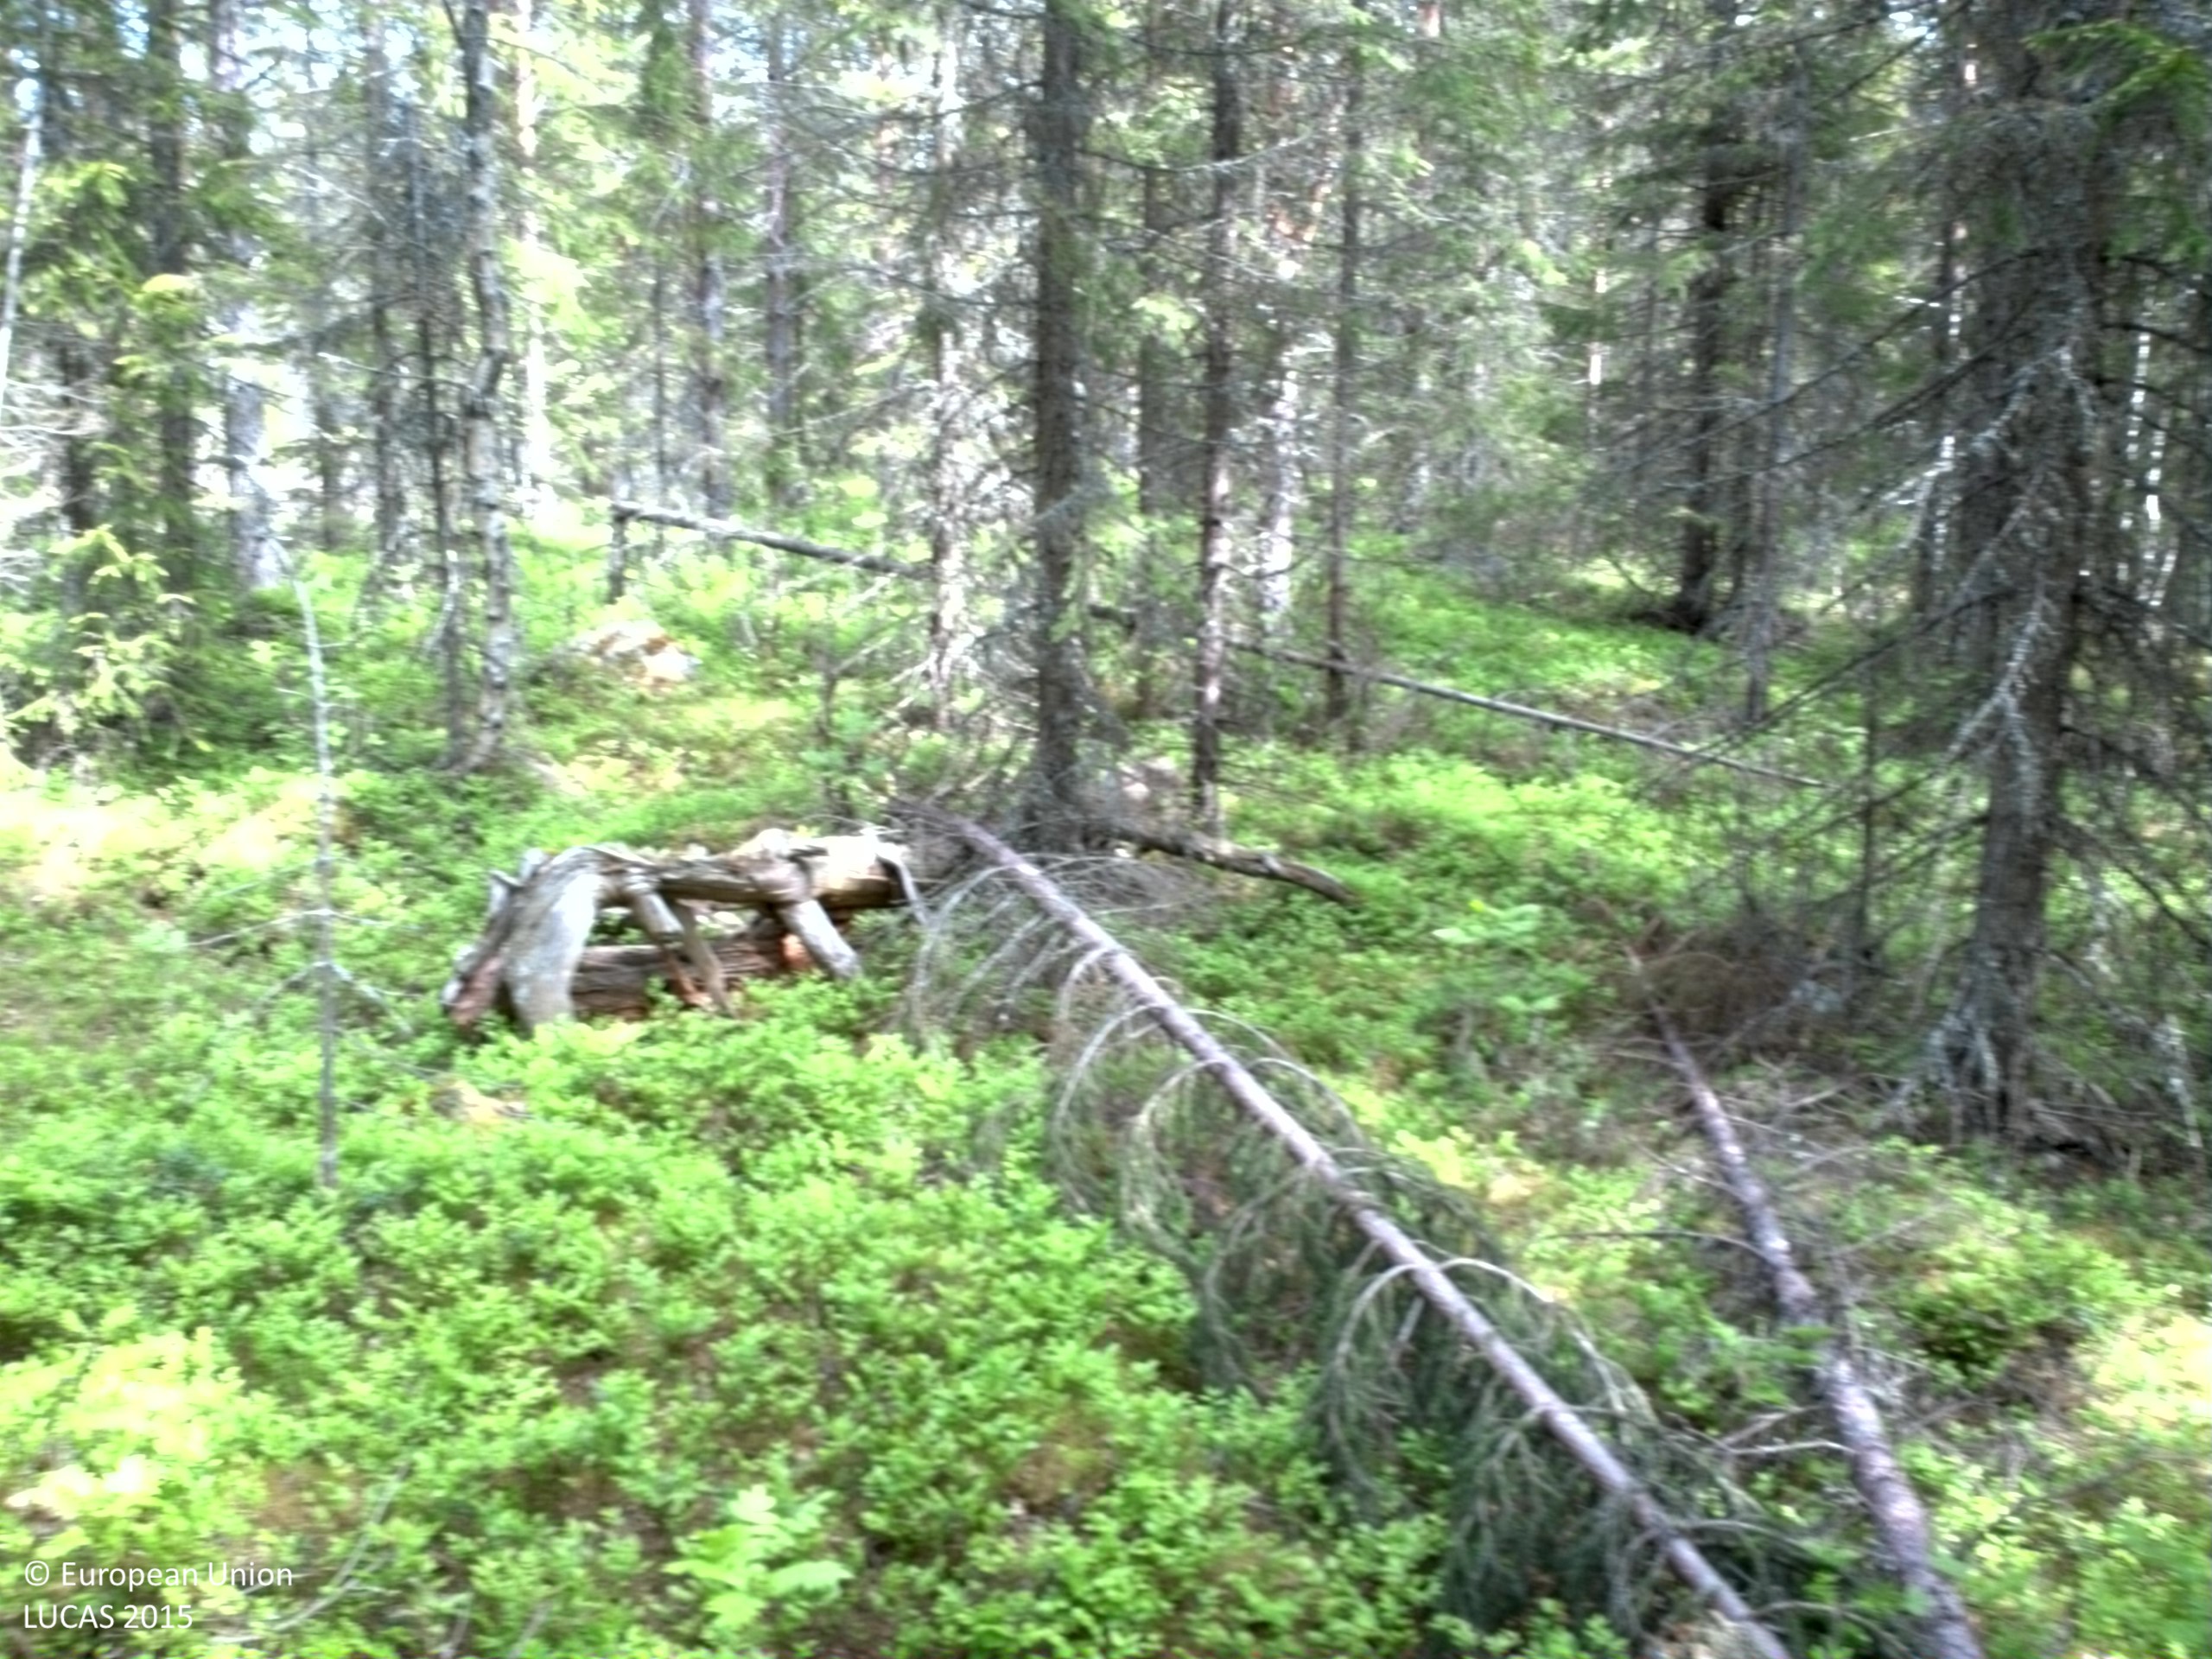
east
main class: Woodland
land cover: Spruce dominated mixed woodland
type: boreal forest
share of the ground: 50 - 75 %
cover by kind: coniferous forest trees 45 %, shrubs 40 %, broadleaved forest trees 15 %
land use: Forestry
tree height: > 5 m
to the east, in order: Spruce dominated mixed woodland; Pine dominated mixed woodland; Pine dominated coniferous woodland
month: June
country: SE
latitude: 63.2402
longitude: 17.8795
